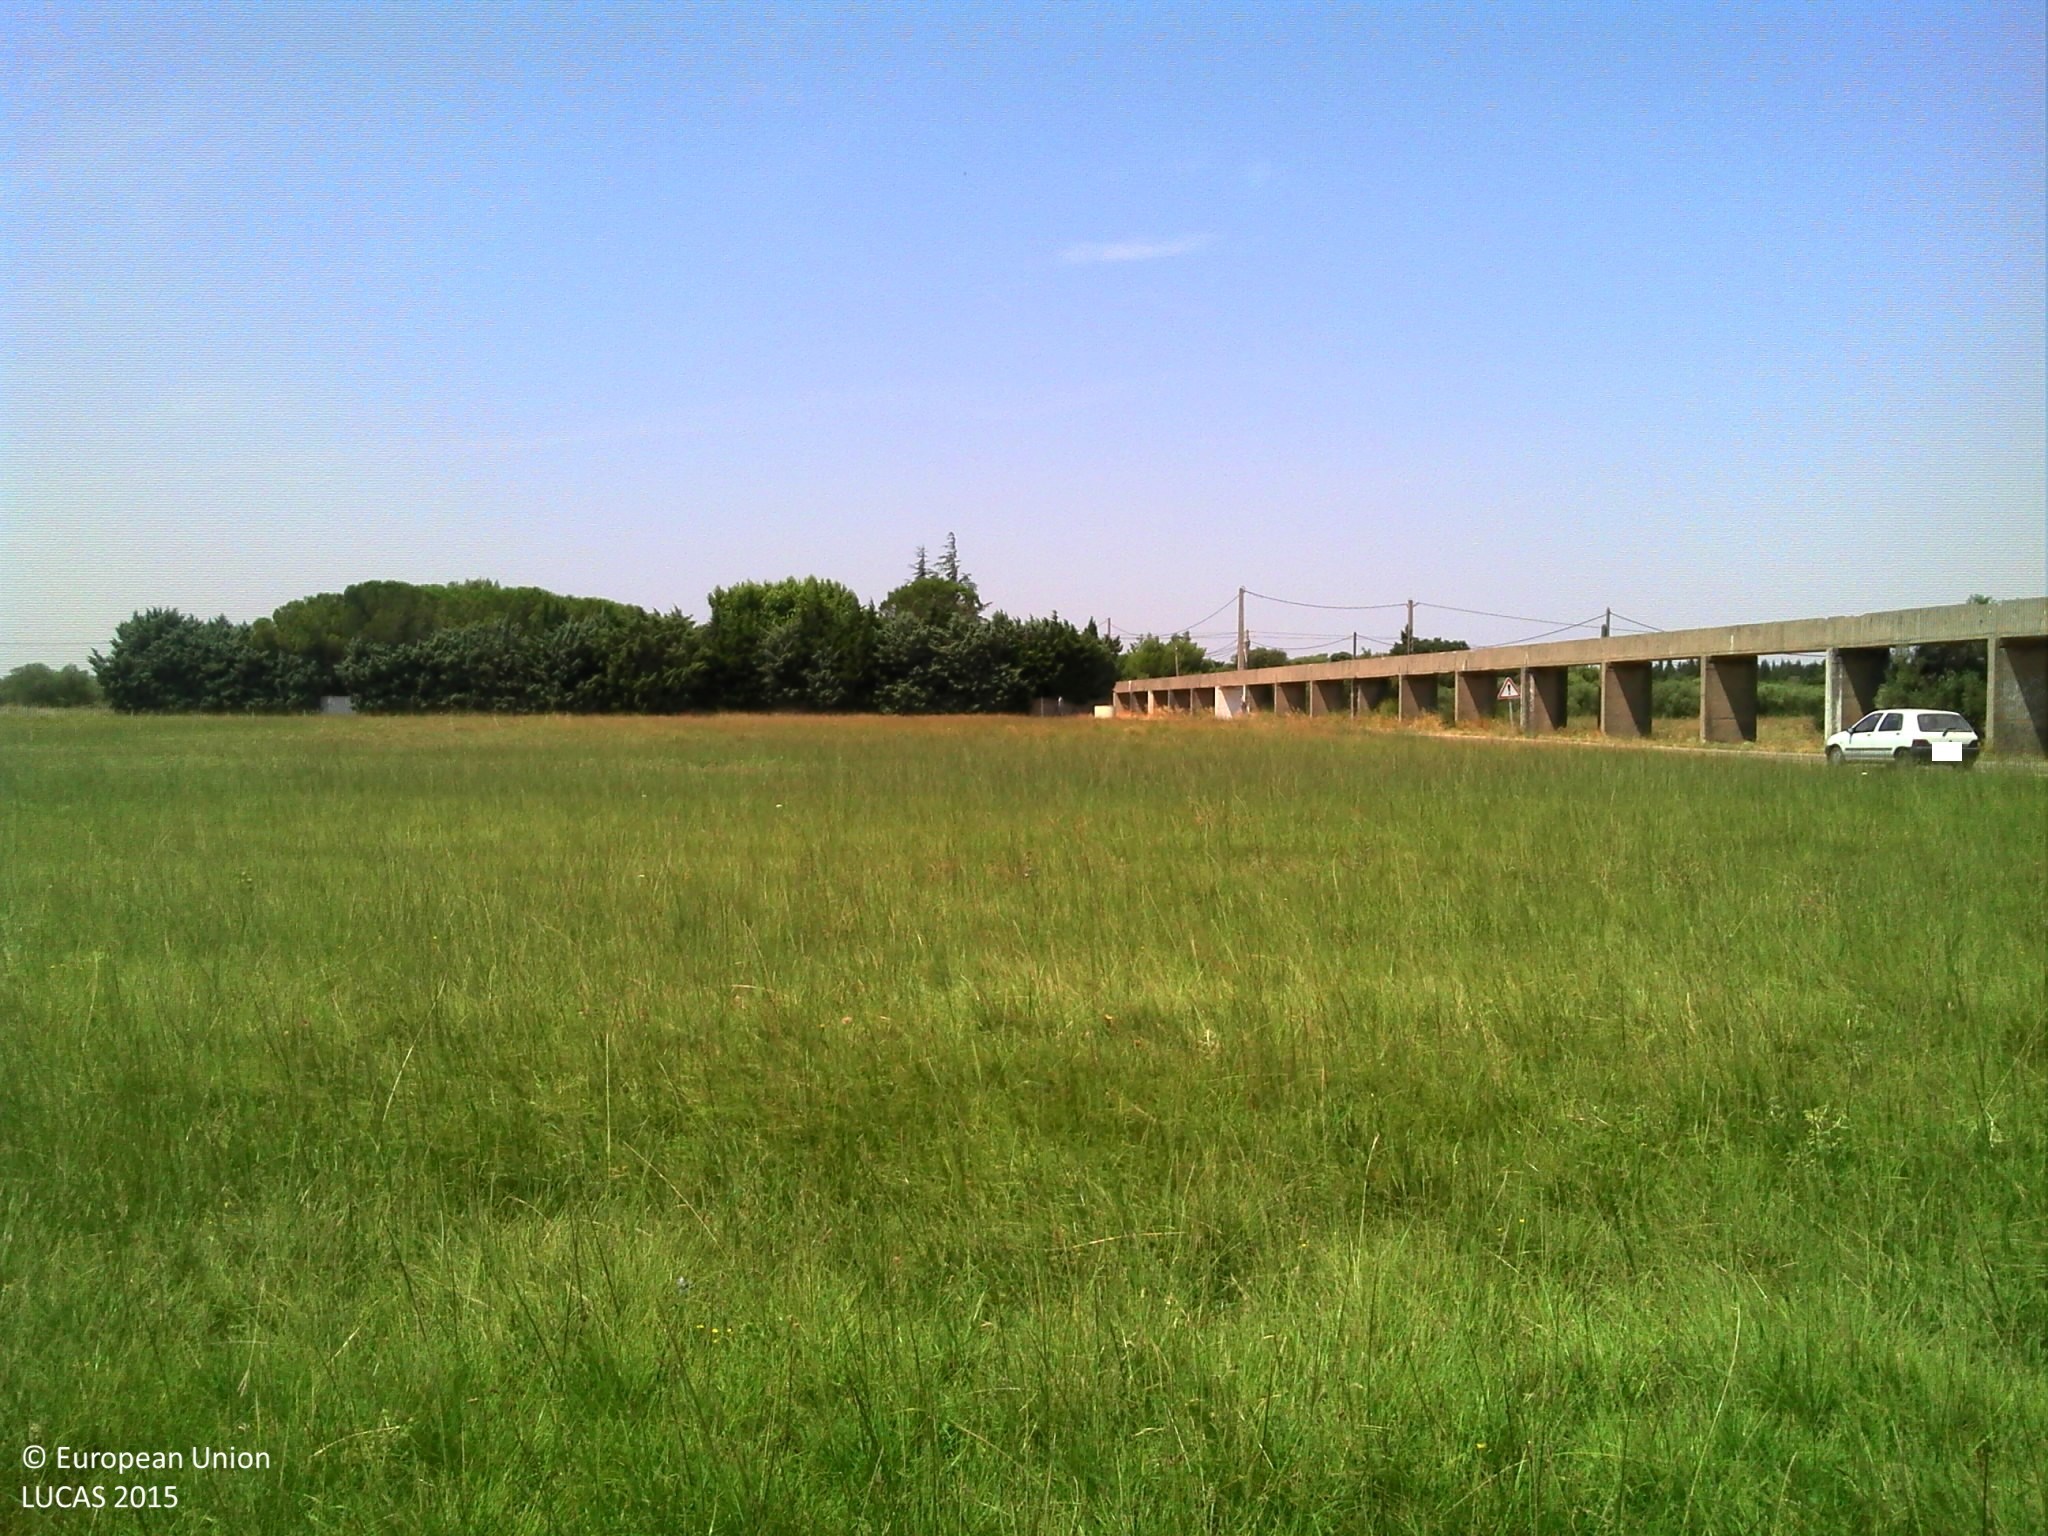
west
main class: Grassland
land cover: Grassland without tree/shrub cover
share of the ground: > 75 %
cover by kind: herbaceous plants 100 %
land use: Agriculture (excluding fallow land and kitchen gardens)
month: July
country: FR
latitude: 43.6723
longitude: 4.6886
